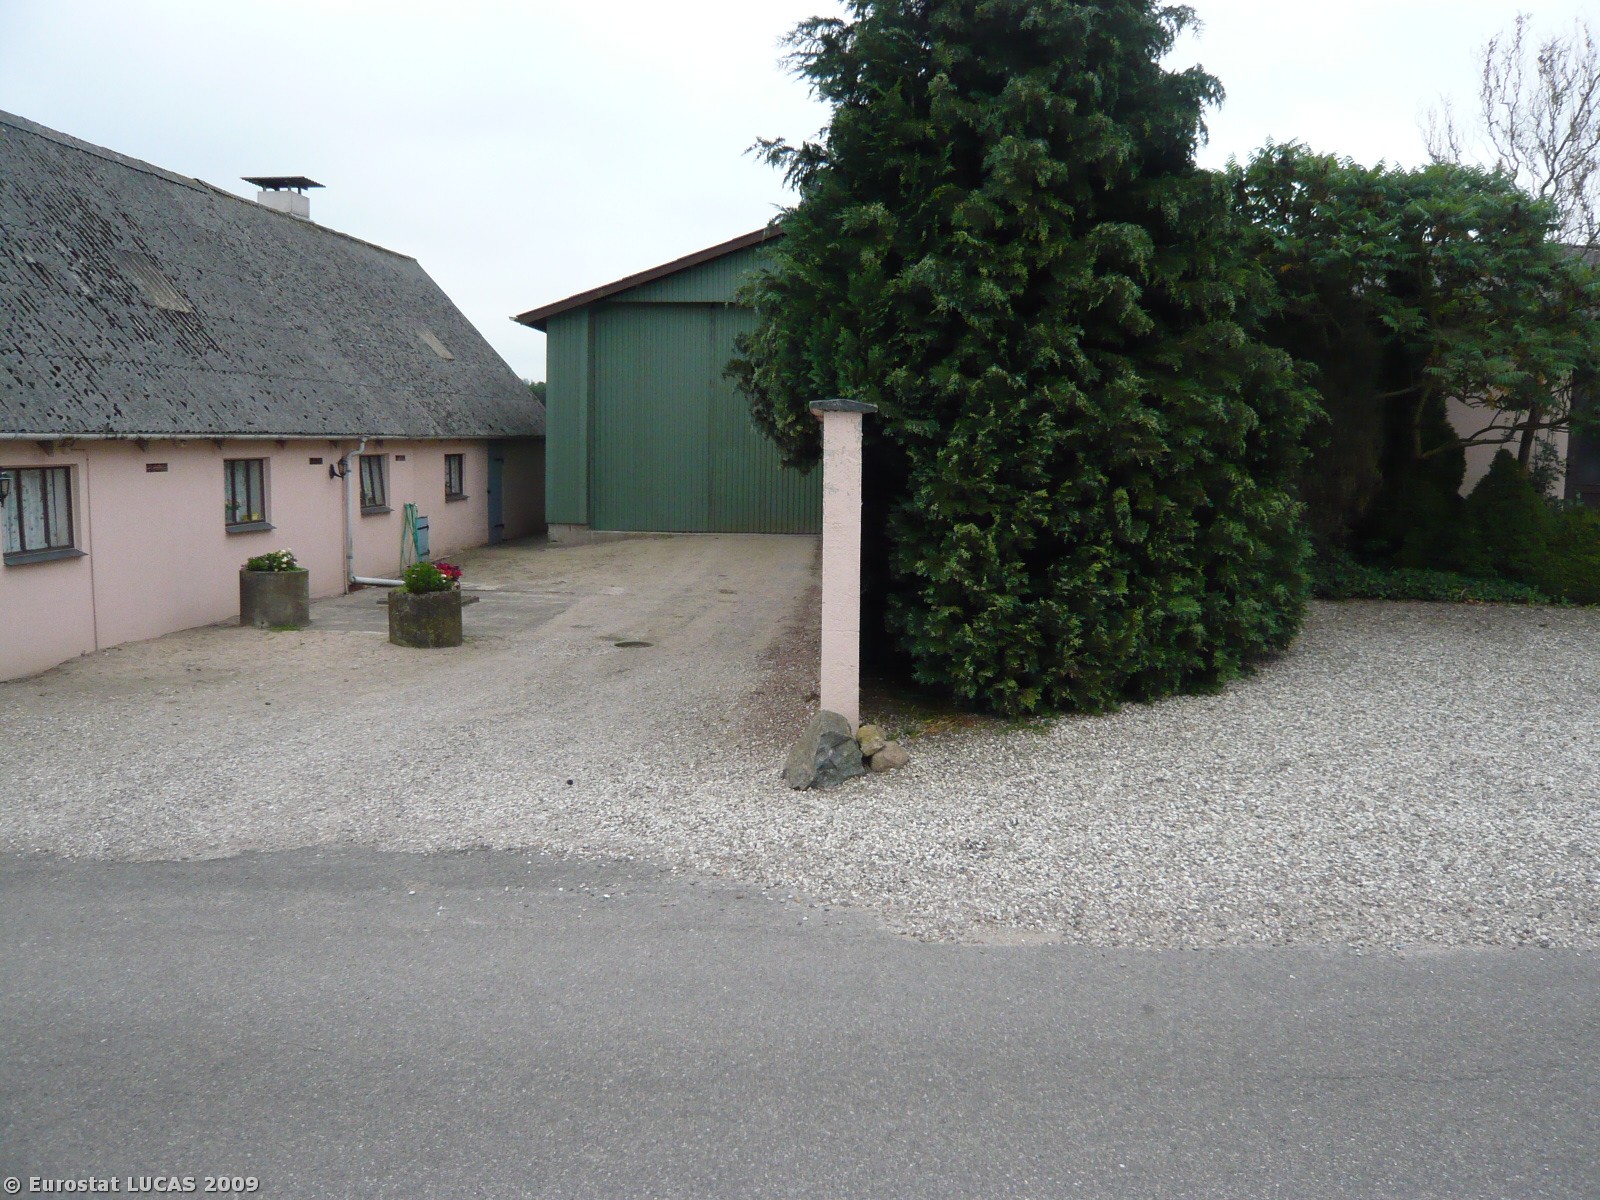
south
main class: Cropland
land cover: Triticale
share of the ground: > 75 %
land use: Agriculture (excluding fallow land and kitchen gardens)
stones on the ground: < 10 %
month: June
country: DK
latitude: 55.1990
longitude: 10.2041
